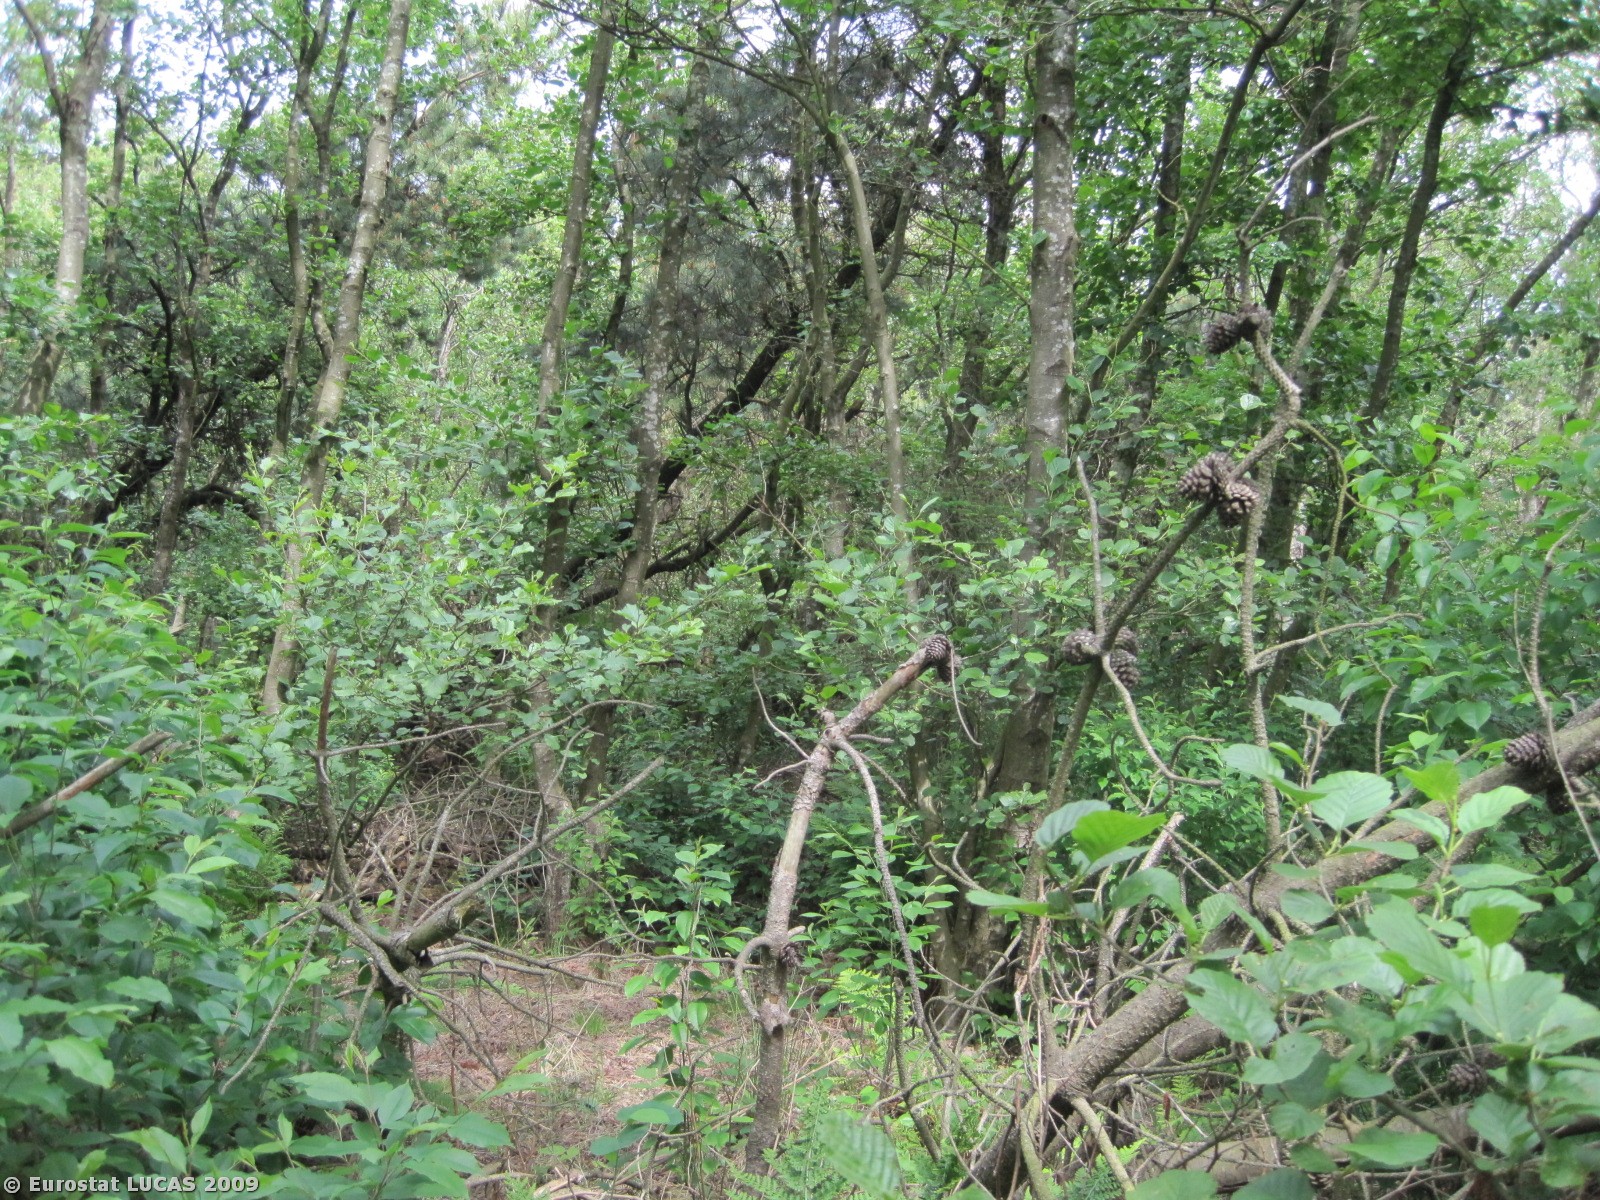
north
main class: Woodland
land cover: Mixed woodland
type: plantations and self-sown exotic forest
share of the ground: 50 - 75 %
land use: Forestry
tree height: > 5 m
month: June
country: DK
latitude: 57.3560
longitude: 9.7179
